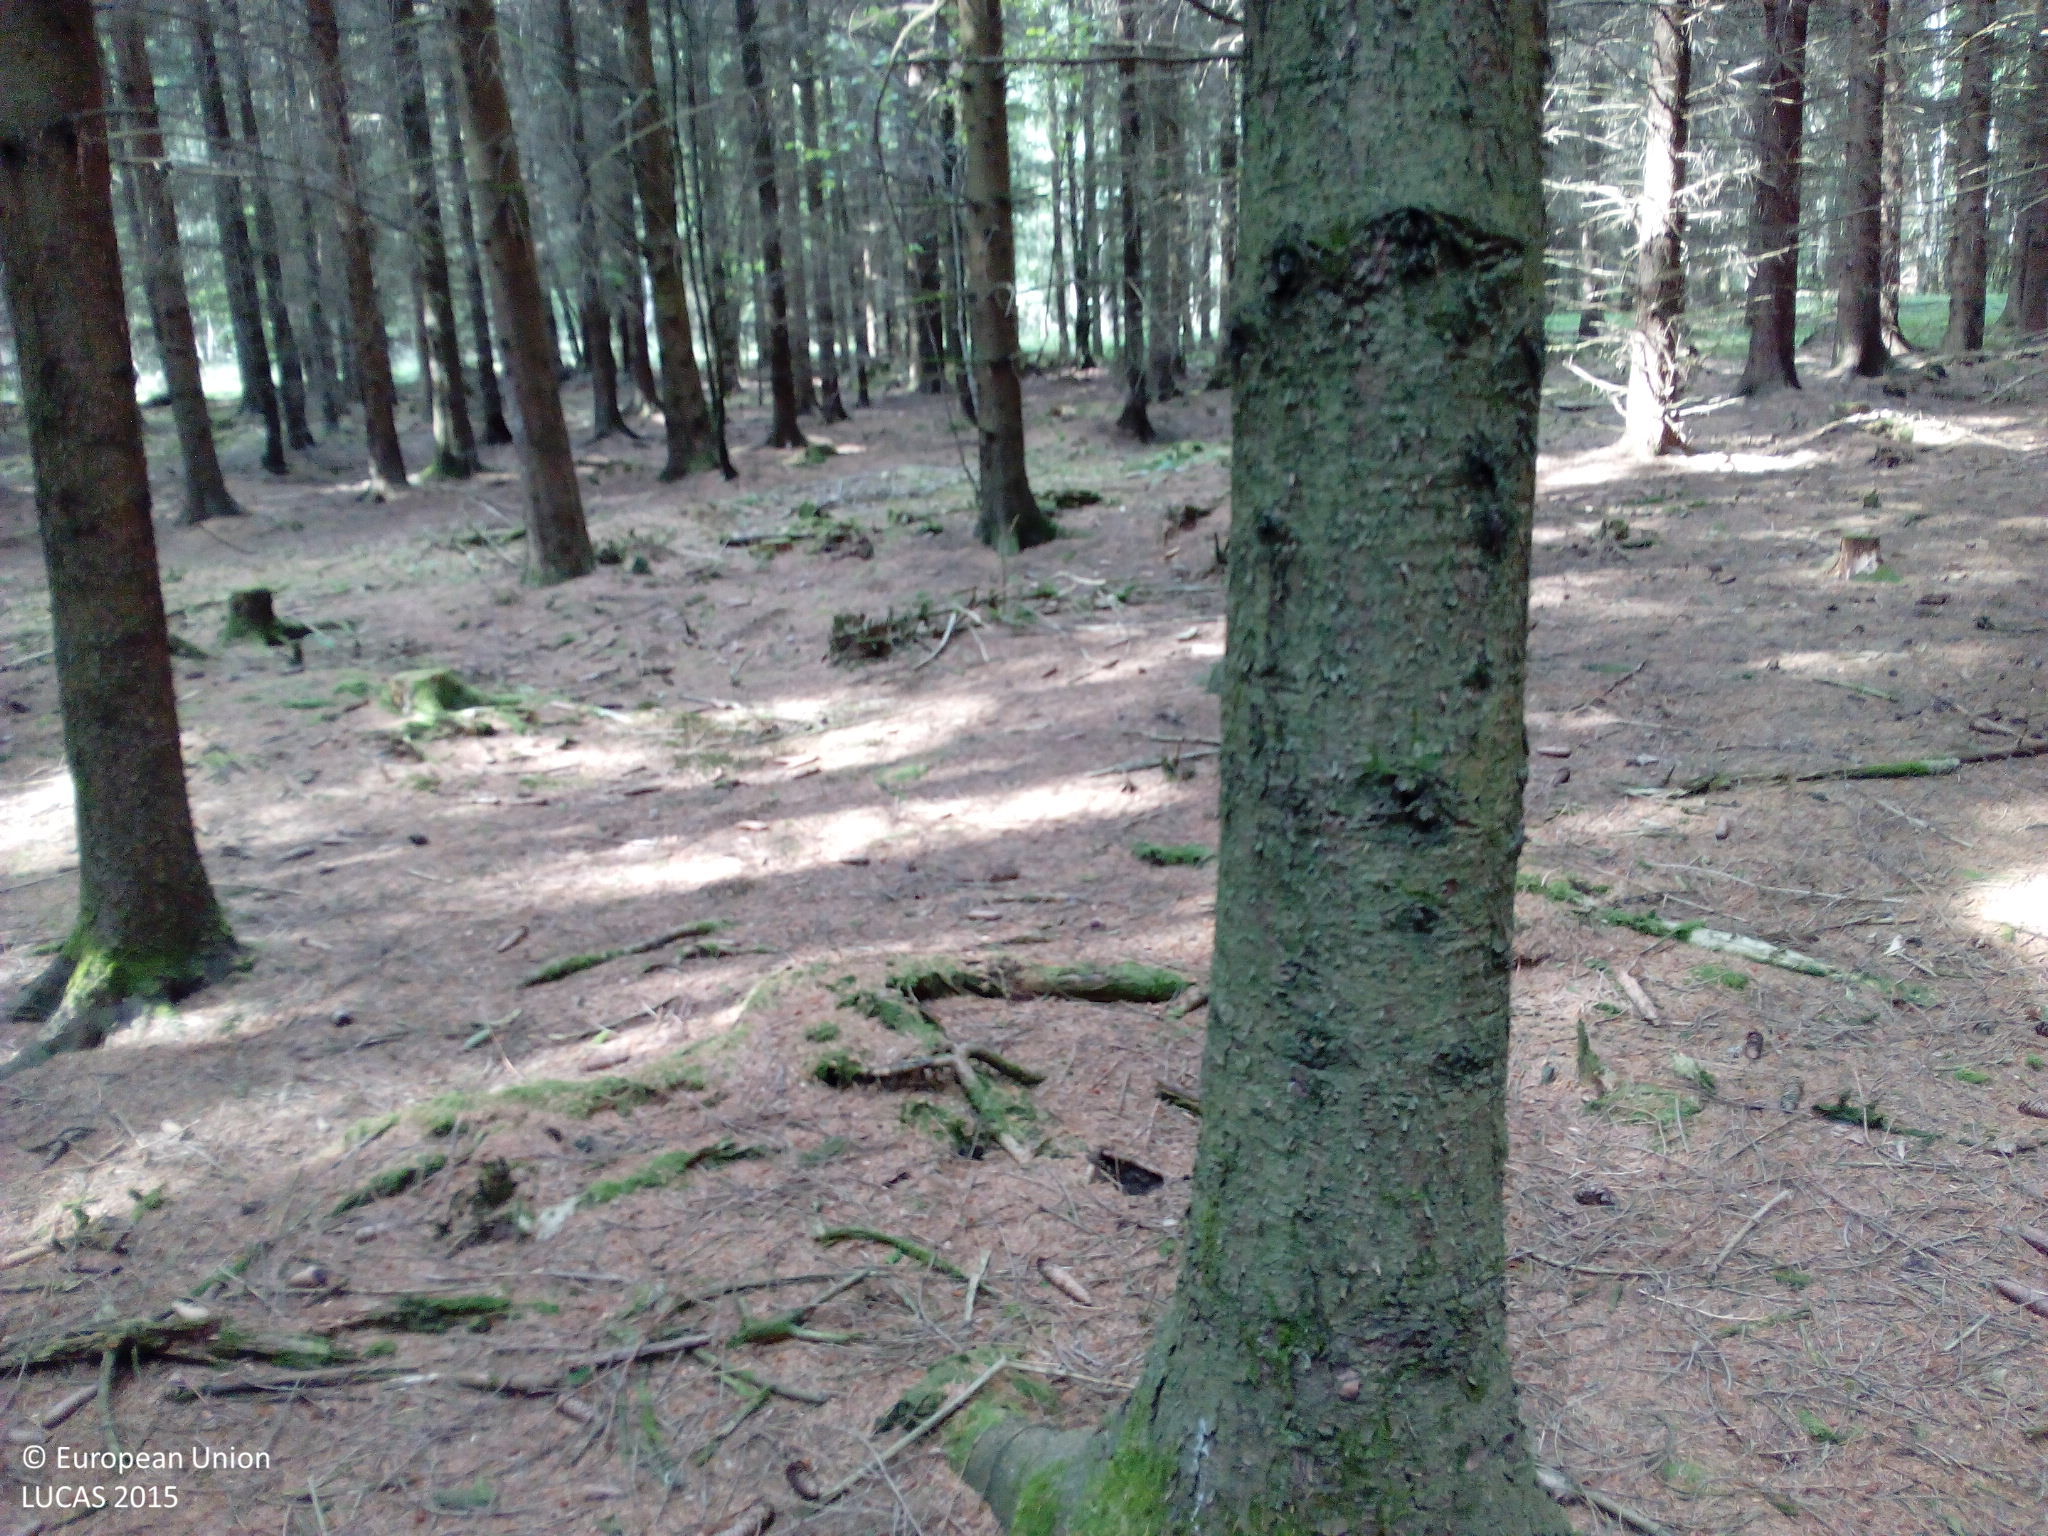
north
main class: Woodland
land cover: Spruce dominated coniferous woodland
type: hemiboreal forest and nemoral coniferous forest and mixed broadleaved-coniferous forest
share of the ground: > 75 %
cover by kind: coniferous forest trees 100 %
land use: Forestry
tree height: > 5 m
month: July
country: DE
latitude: 49.6624
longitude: 7.1325
